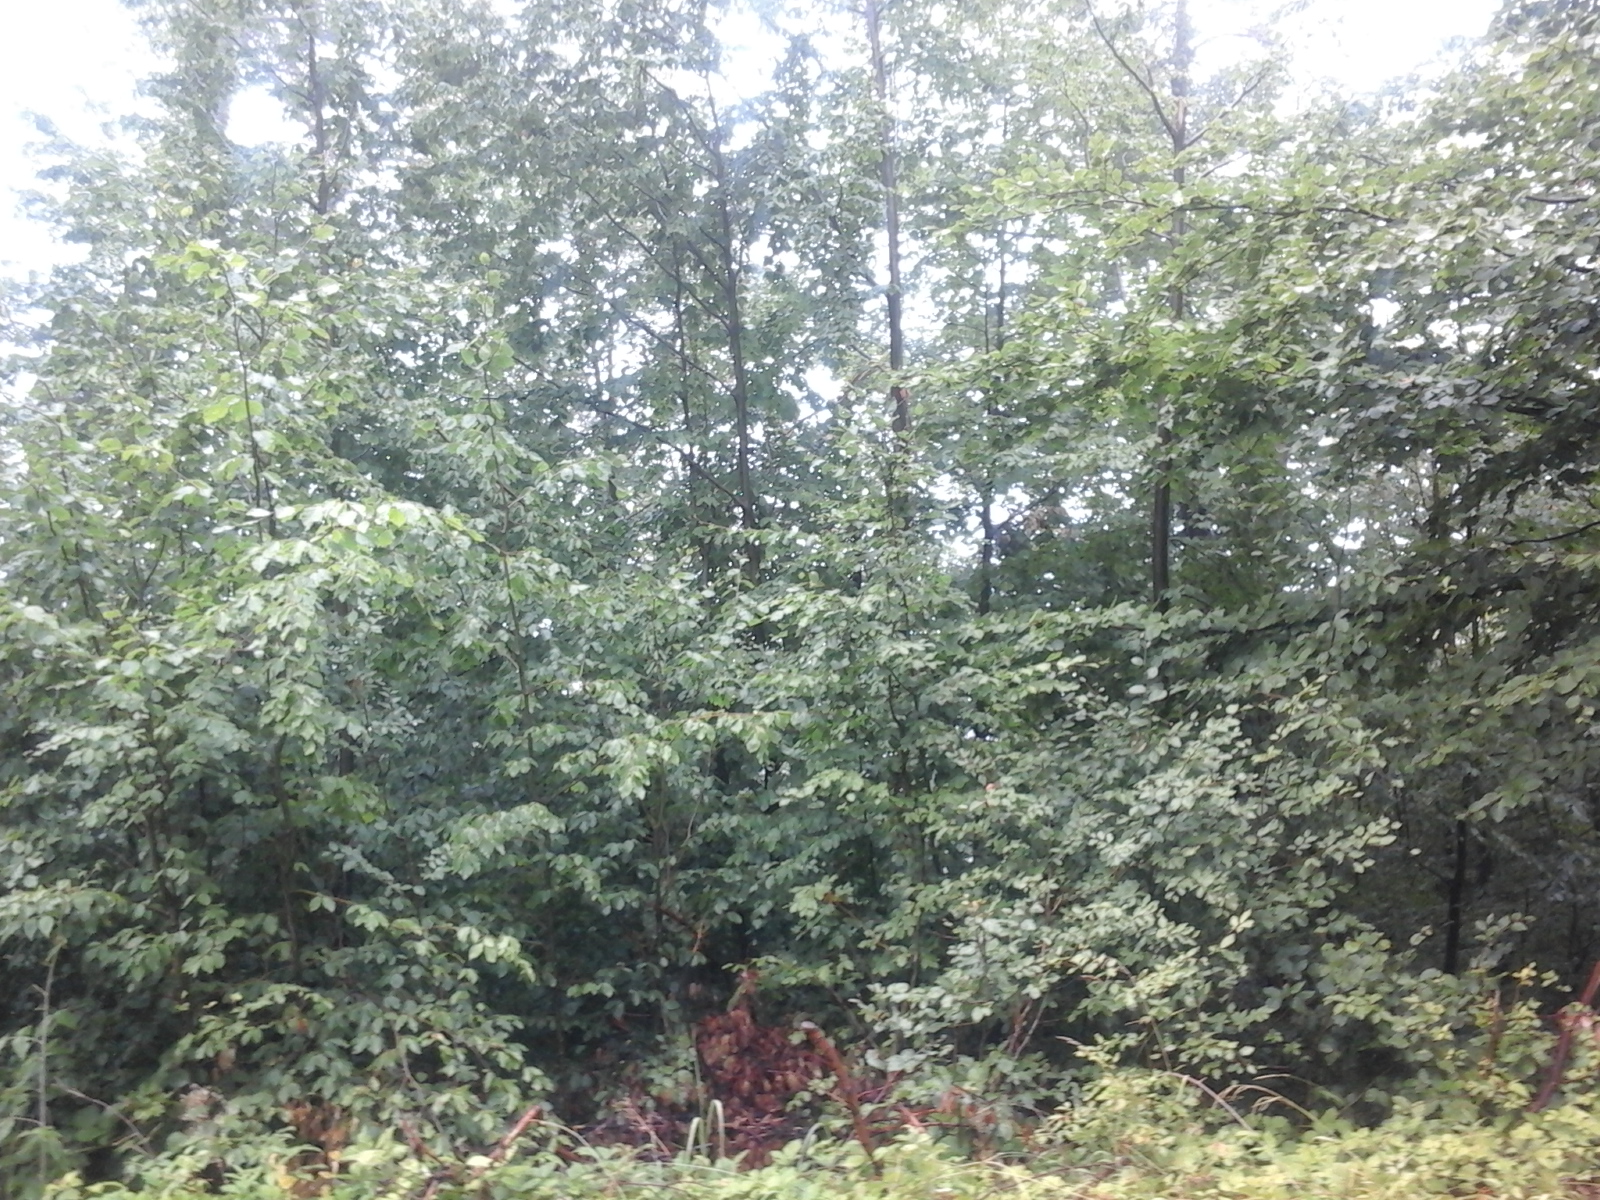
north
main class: Woodland
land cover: Broadleaved woodland
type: beech forest
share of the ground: > 75 %
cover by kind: broadleaved forest trees 100 %
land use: Forestry
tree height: > 5 m
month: August
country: RO
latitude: 45.0404
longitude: 22.7276
